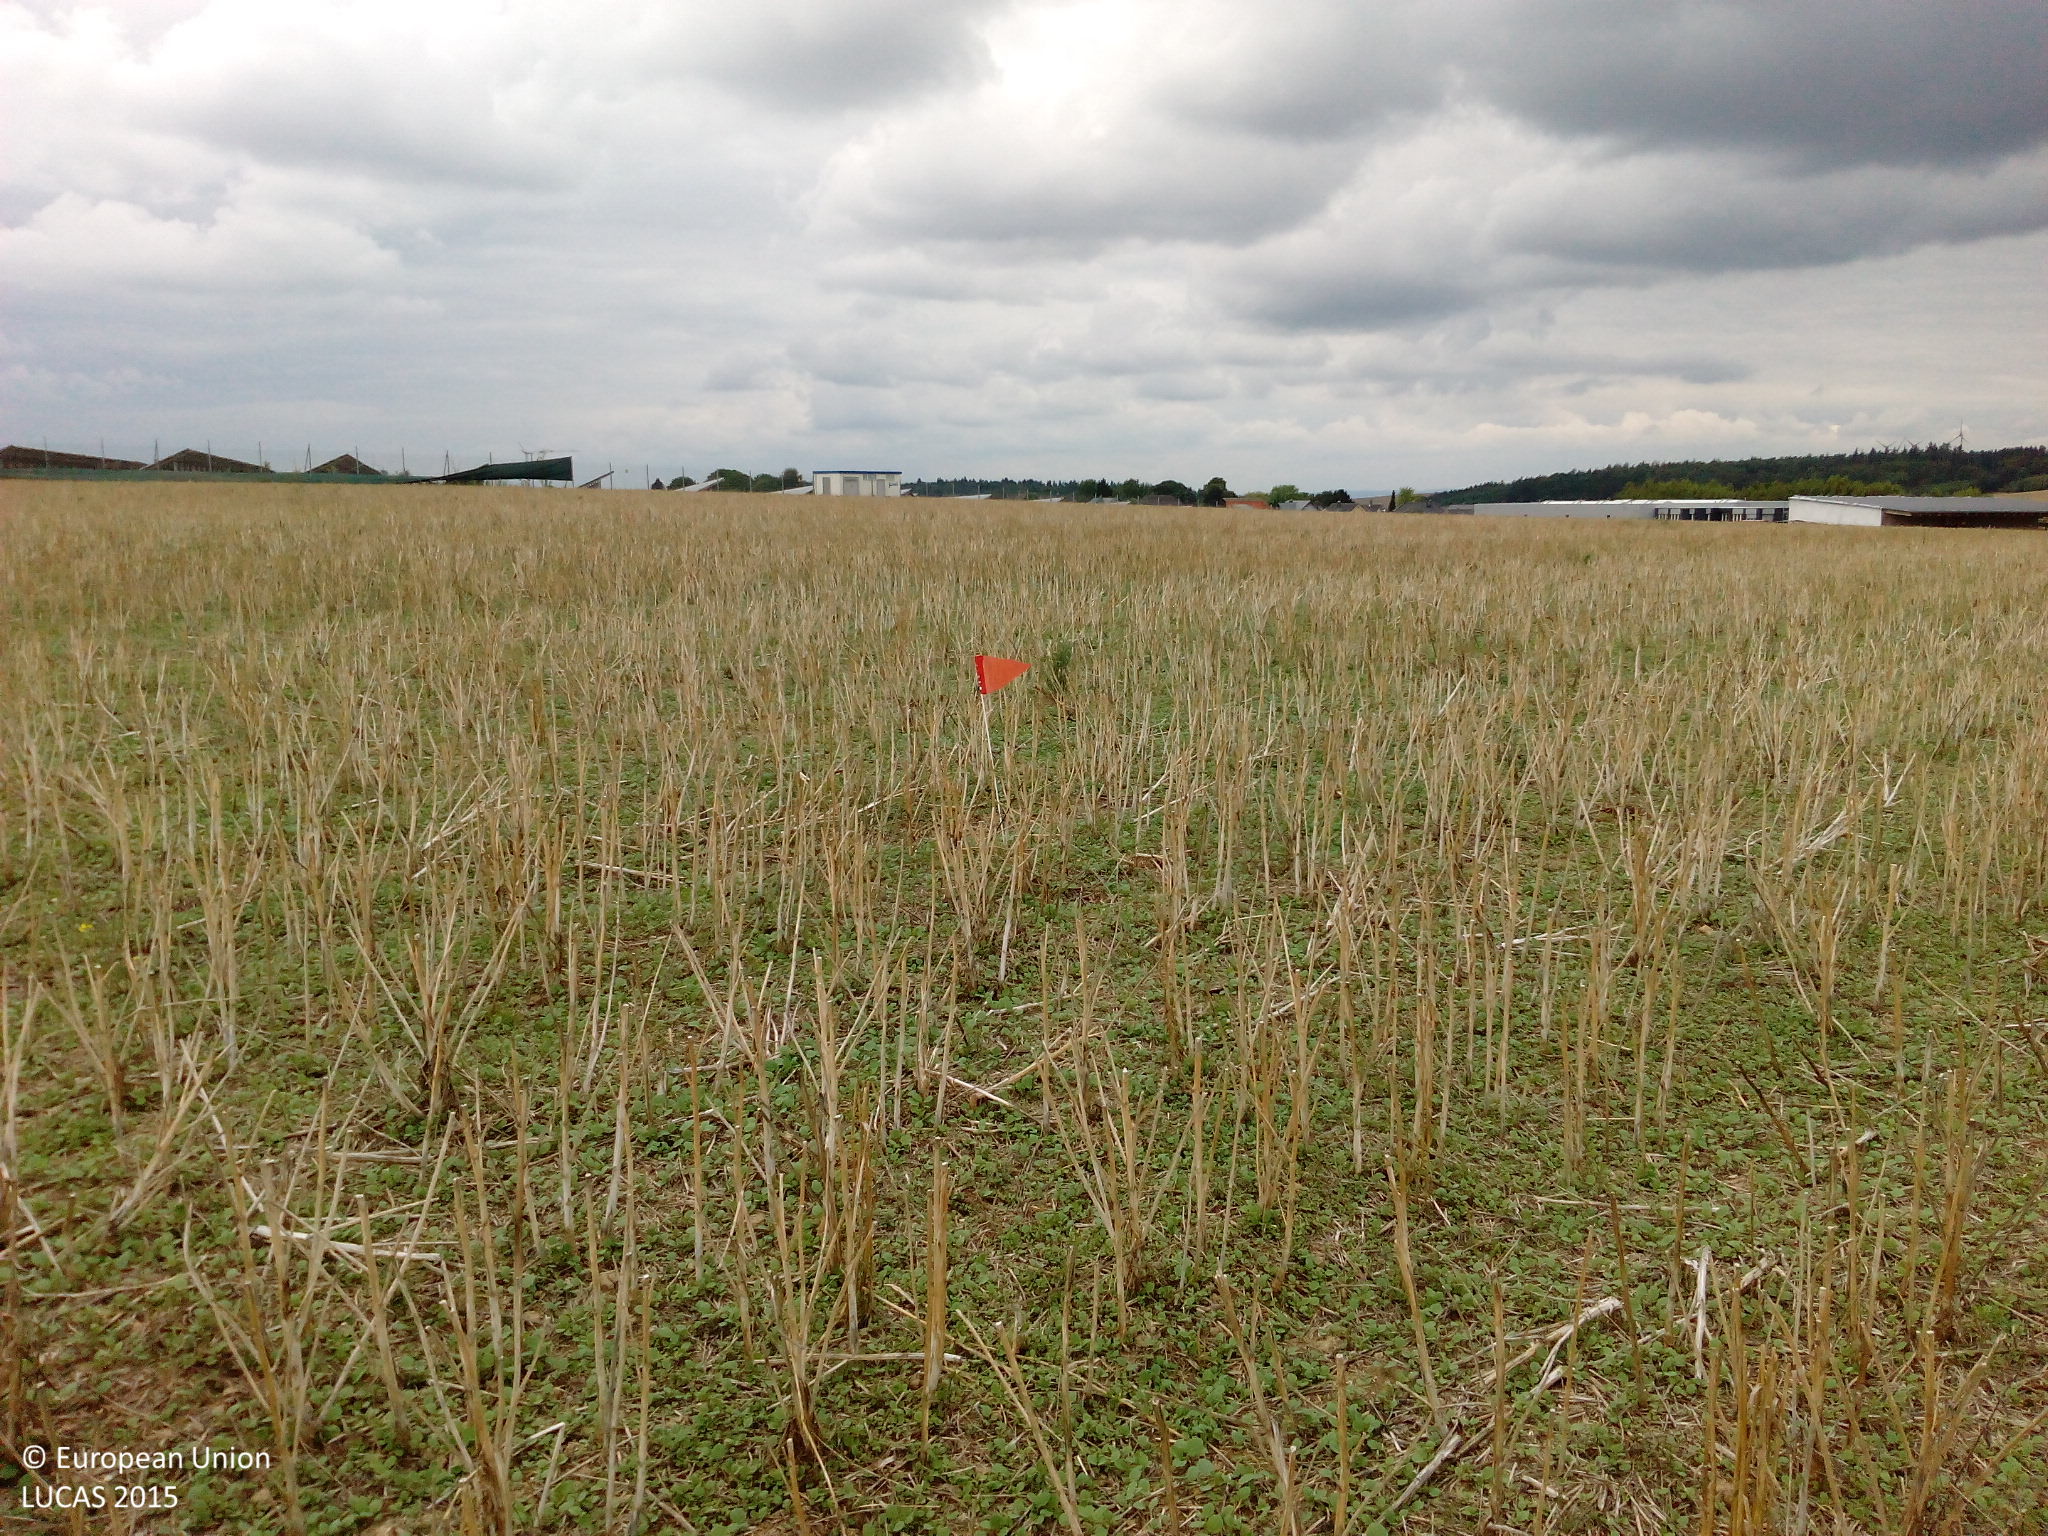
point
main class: Cropland
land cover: Rape and turnip rape
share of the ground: < 10 %
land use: Agriculture (excluding fallow land and kitchen gardens)
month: August
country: DE
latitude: 50.0849
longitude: 7.4986
